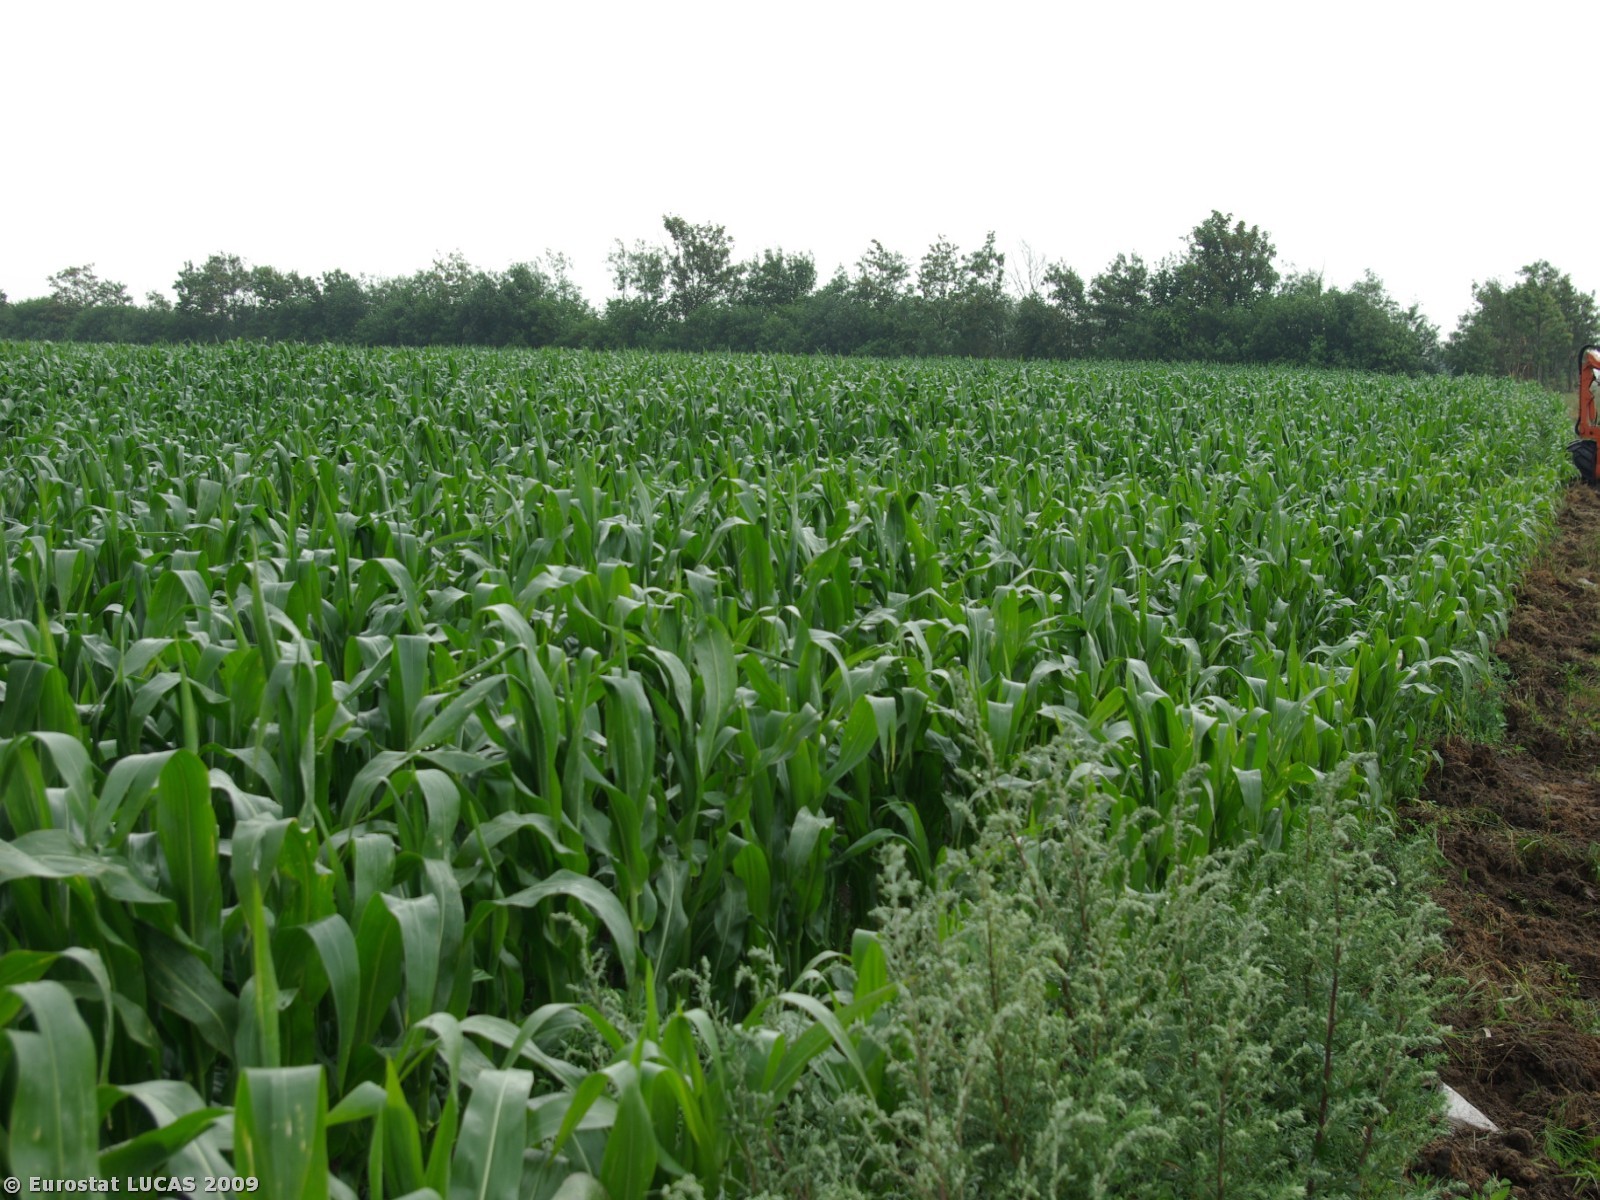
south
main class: Cropland
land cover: Maize
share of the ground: > 75 %
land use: Agriculture (excluding fallow land and kitchen gardens)
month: July
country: DK
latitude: 55.2287
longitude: 8.7275
